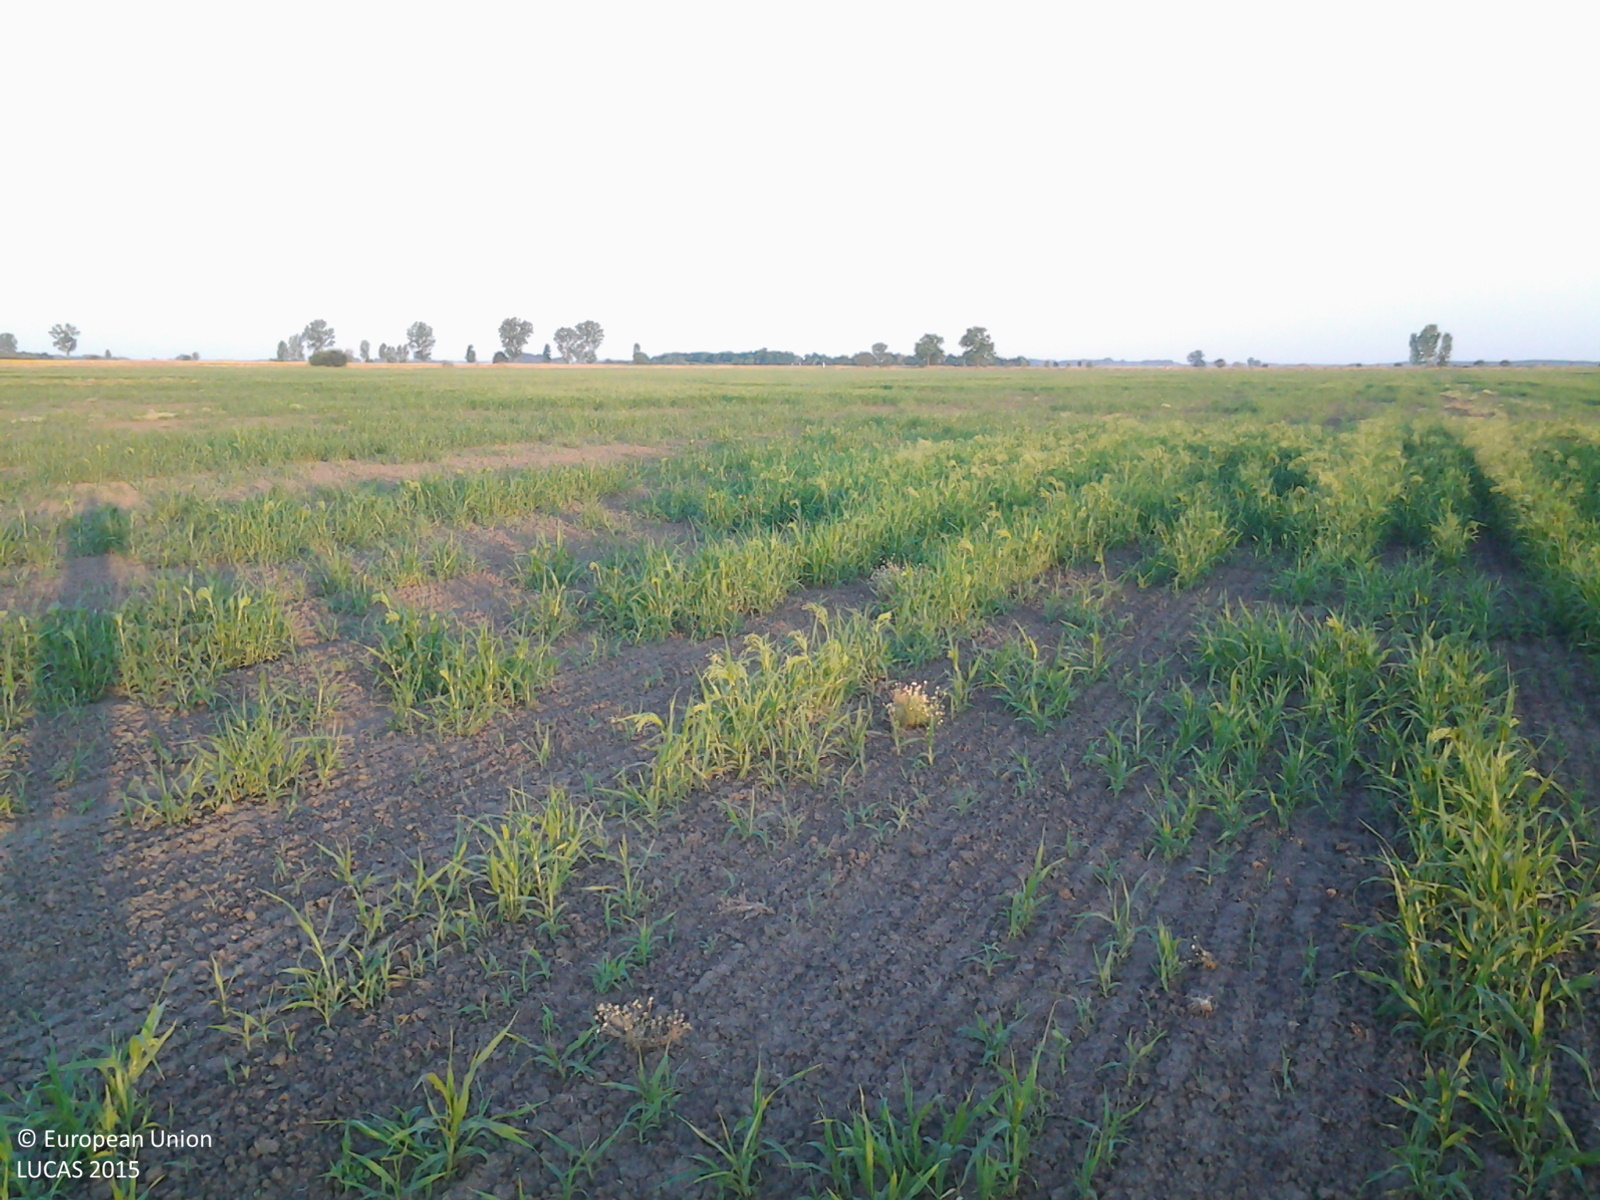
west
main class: Cropland
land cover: Other cereals
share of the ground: 50 - 75 %
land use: Agriculture (excluding fallow land and kitchen gardens)
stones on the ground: < 10 %
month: July
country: HU
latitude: 47.1151
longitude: 20.9335
